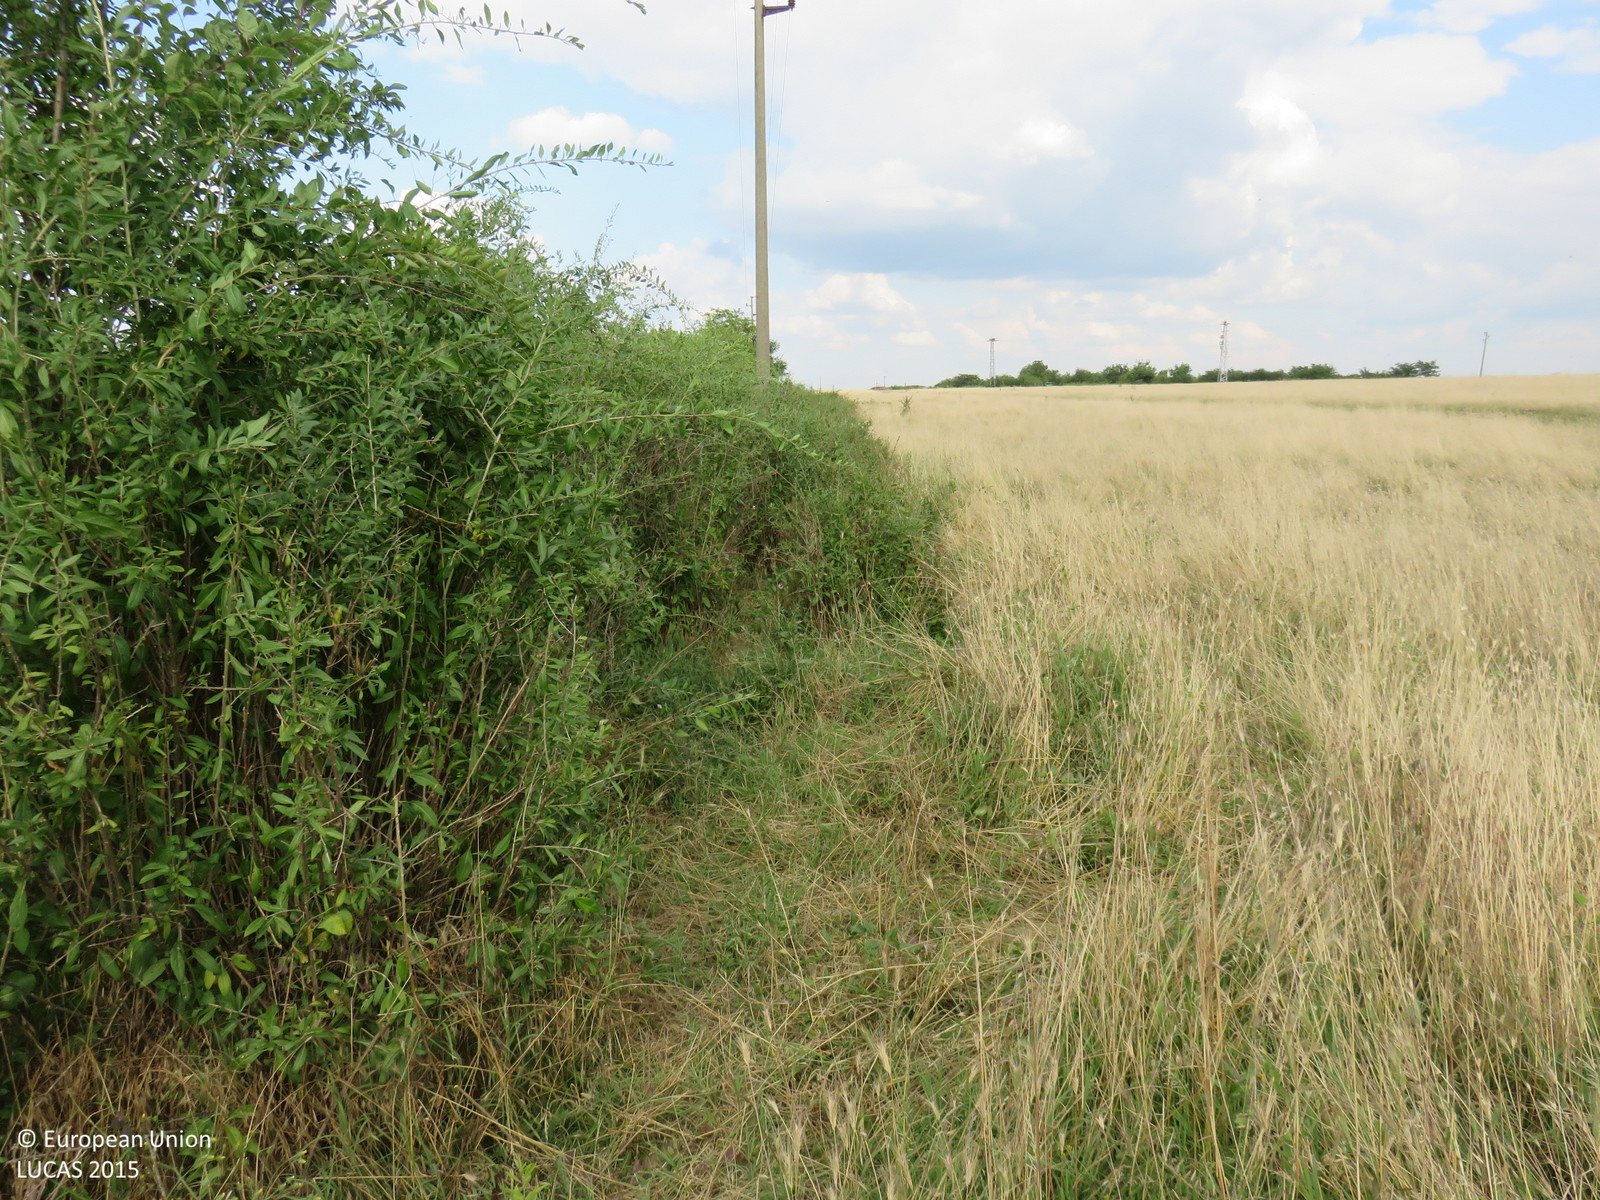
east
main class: Grassland
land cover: Grassland without tree/shrub cover
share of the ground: > 75 %
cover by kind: herbaceous plants 100 %
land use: Residential
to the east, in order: Grassland without tree/shrub cover; Abandoned hedges; Spontaneously vegetated surfaces; Abandoned hedges; Grass margins; Tracks; Grass margins; Abandoned hedges; Spontaneously vegetated surfaces; Fences; Grassland with sparse tree/shrub cover; Paved roads, cycling and walking lanes; Grass margins; Electric lines; Fences; Vineyards; Other fresh vegetables
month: June
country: BG
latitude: 43.3364
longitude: 24.9309
